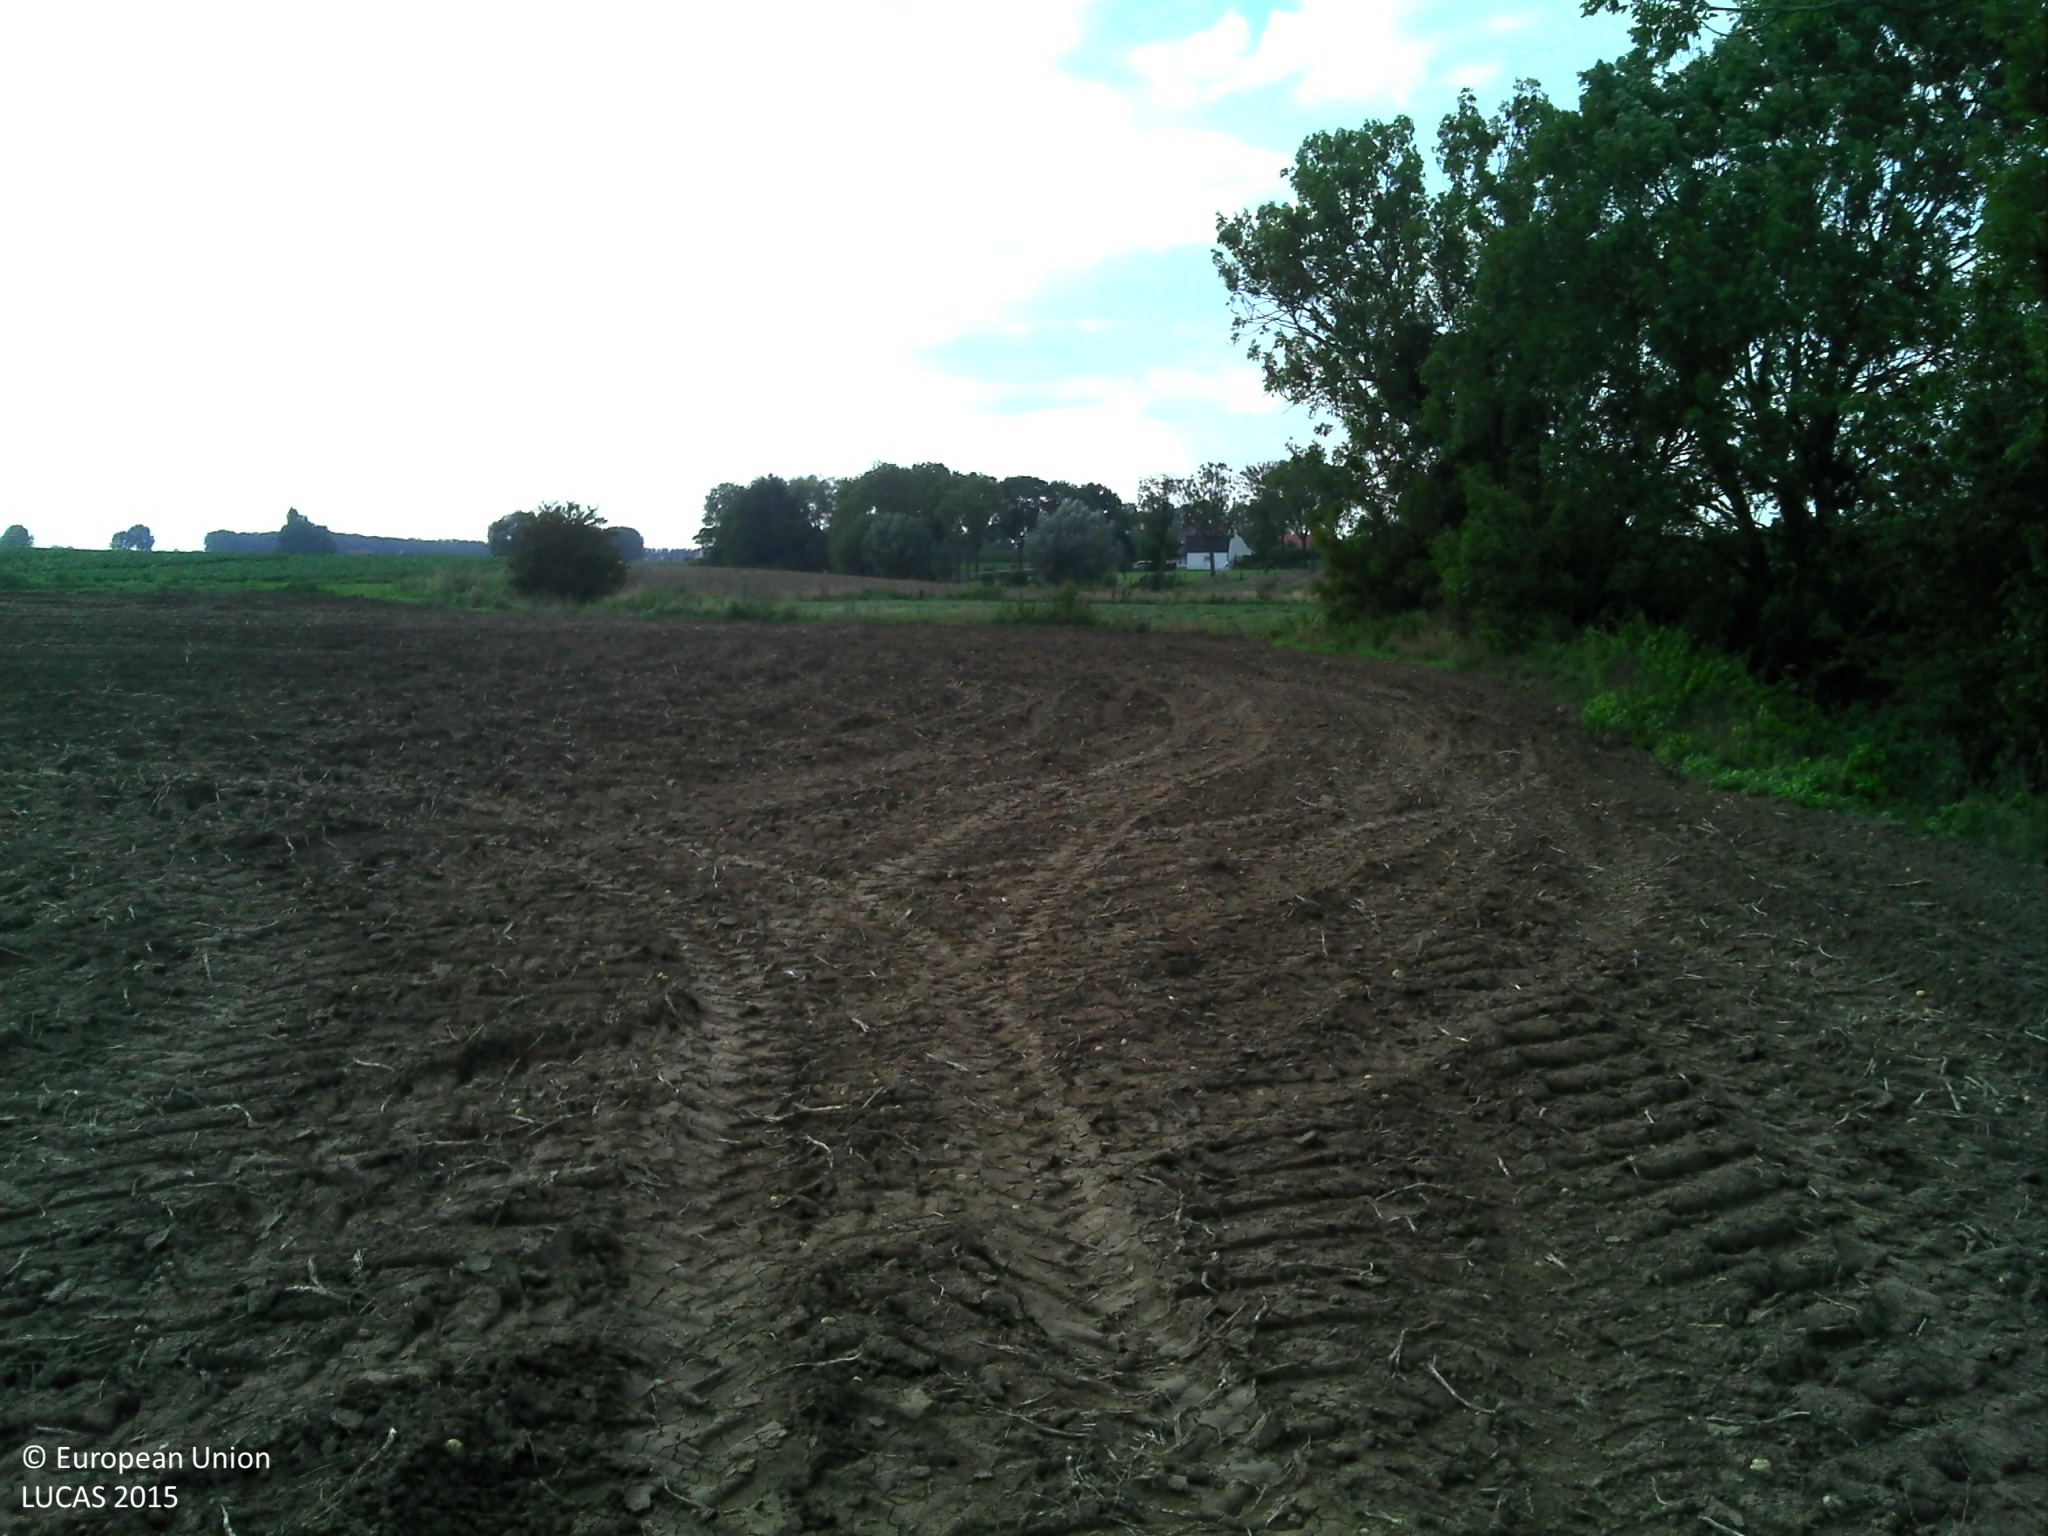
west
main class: Cropland
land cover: Potatoes
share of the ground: < 10 %
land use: Agriculture (excluding fallow land and kitchen gardens)
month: September
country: BE
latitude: 50.8923
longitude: 2.7523
